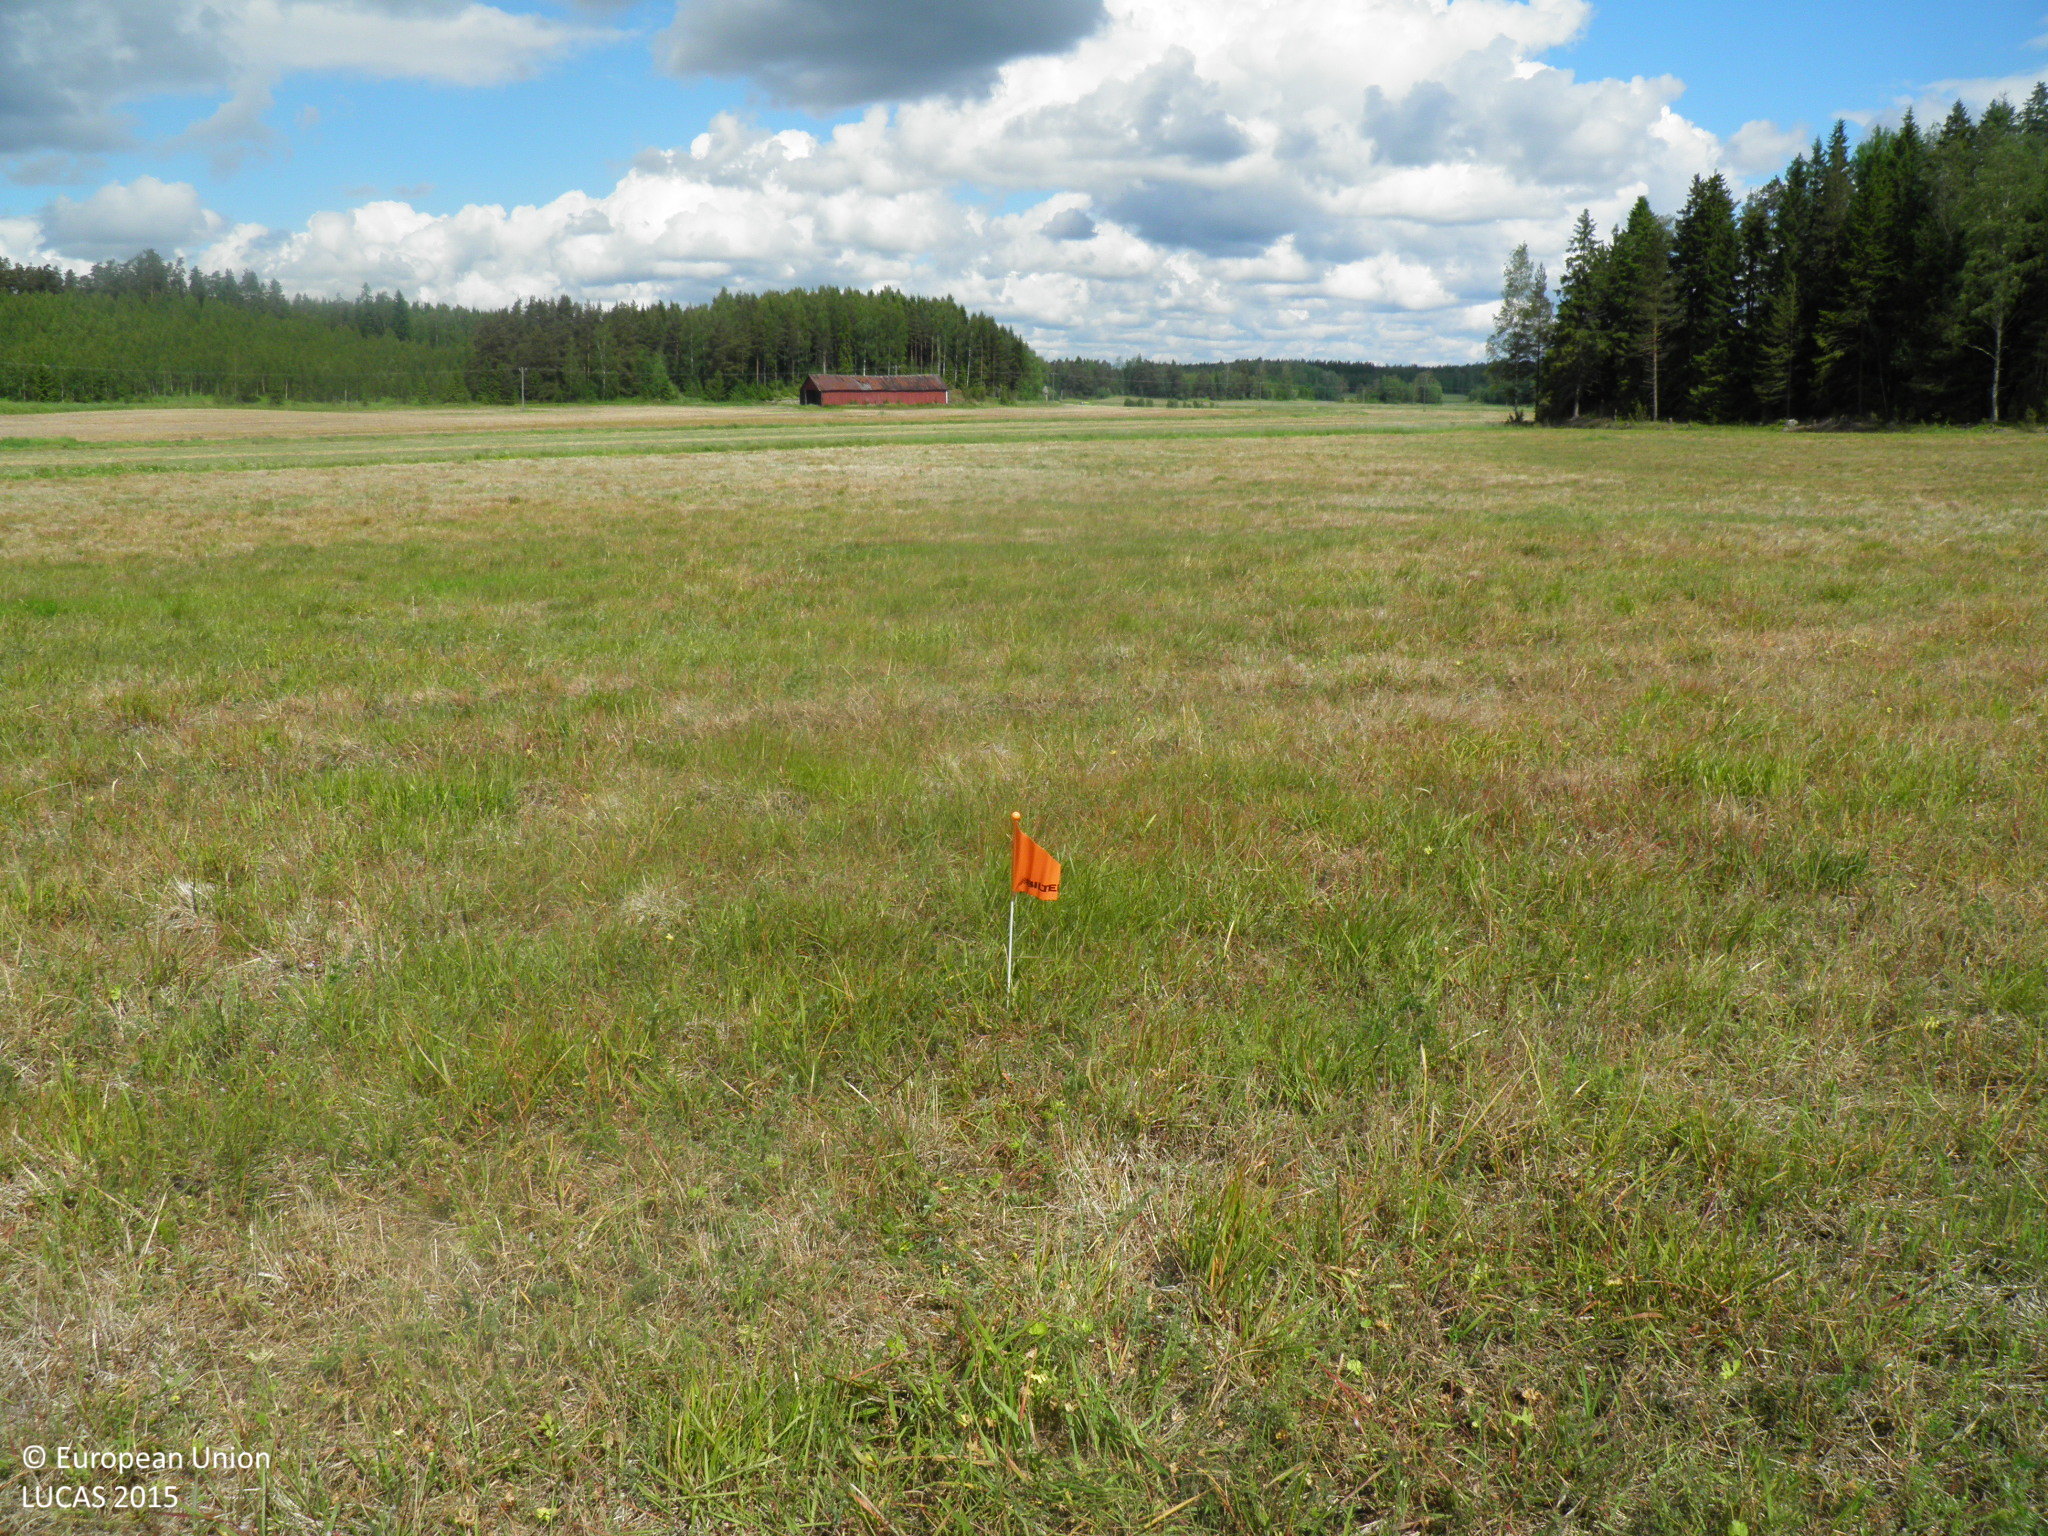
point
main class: Grassland
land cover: Spontaneously vegetated surfaces
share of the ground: > 75 %
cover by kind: herbaceous plants 90 %, unconsolidated bare surface 10 %
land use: Fallow land
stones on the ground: < 10 %
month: June
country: FI
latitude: 60.2943
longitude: 22.5368
